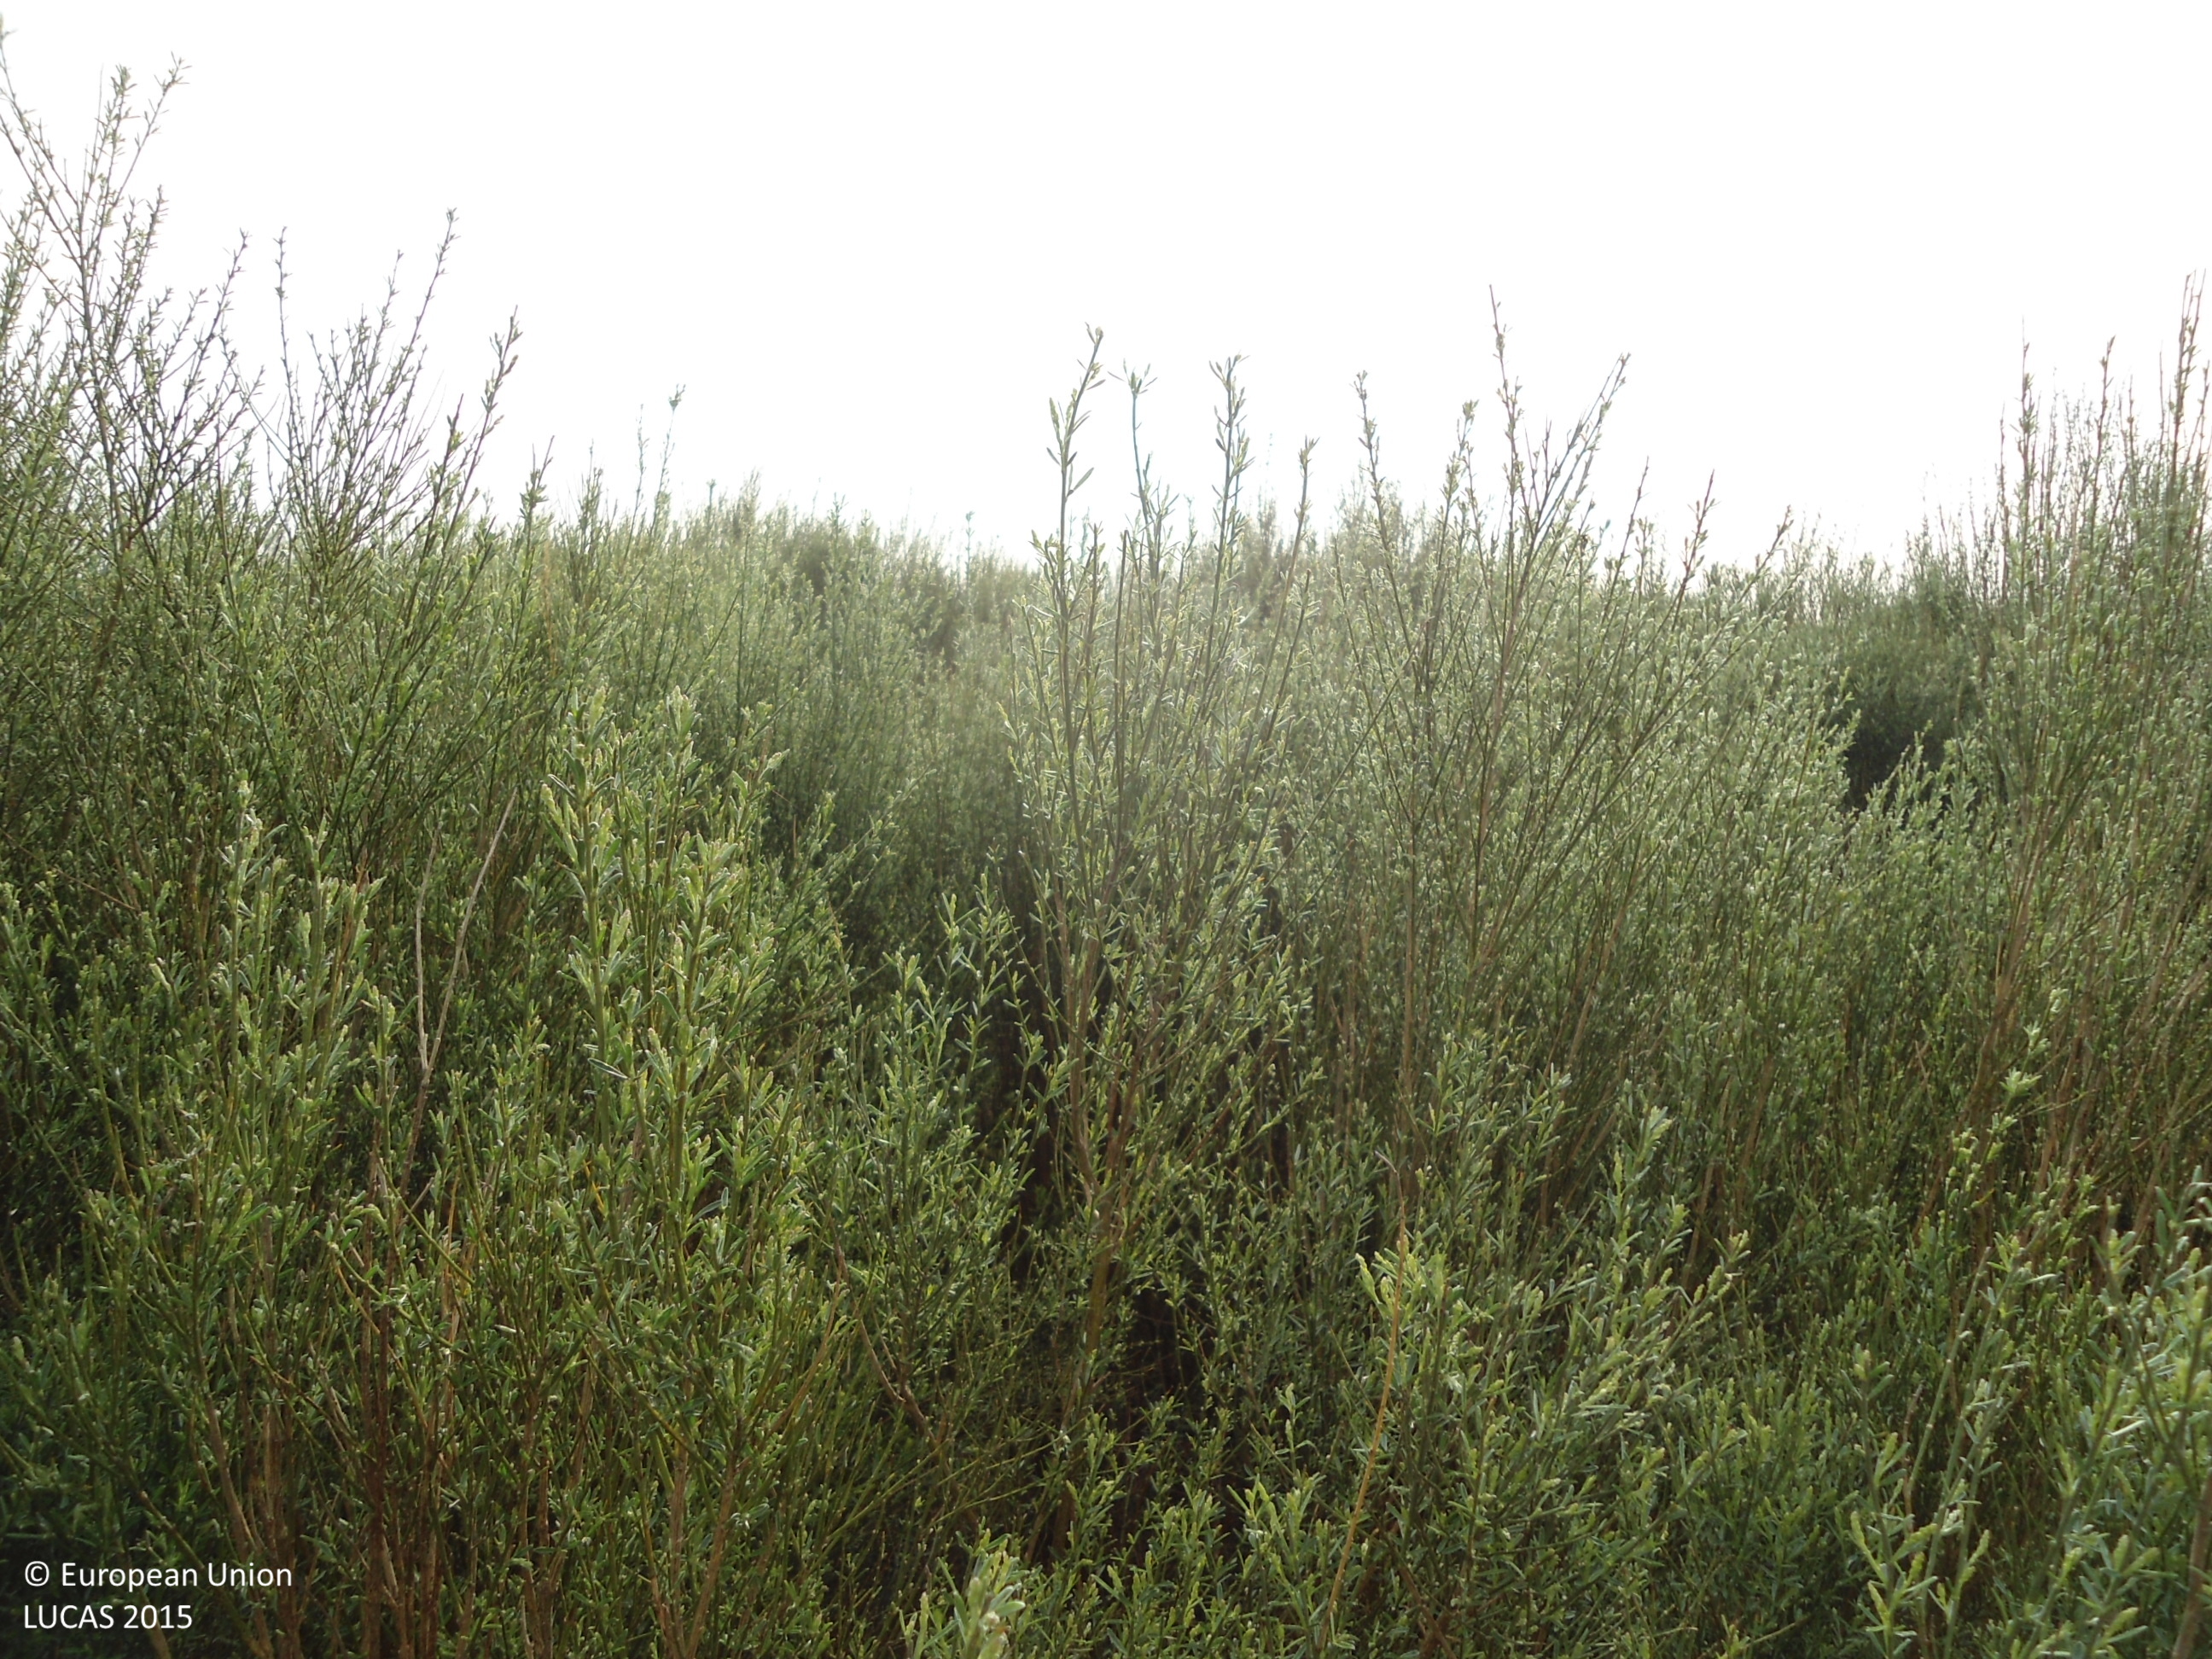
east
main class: Cropland
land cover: Nuts trees
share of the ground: < 10 %
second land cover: Shrubland without tree cover
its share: 50 - 75 %
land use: Abandoned areas
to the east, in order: Nuts trees; Shrubland without tree cover; Tracks; Grassland with sparse tree/shrub cover; Shrubland without tree cover; Tracks; Broadleaved woodland; Shrubland without tree cover
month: April
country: ES
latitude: 41.7462
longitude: -6.5211
